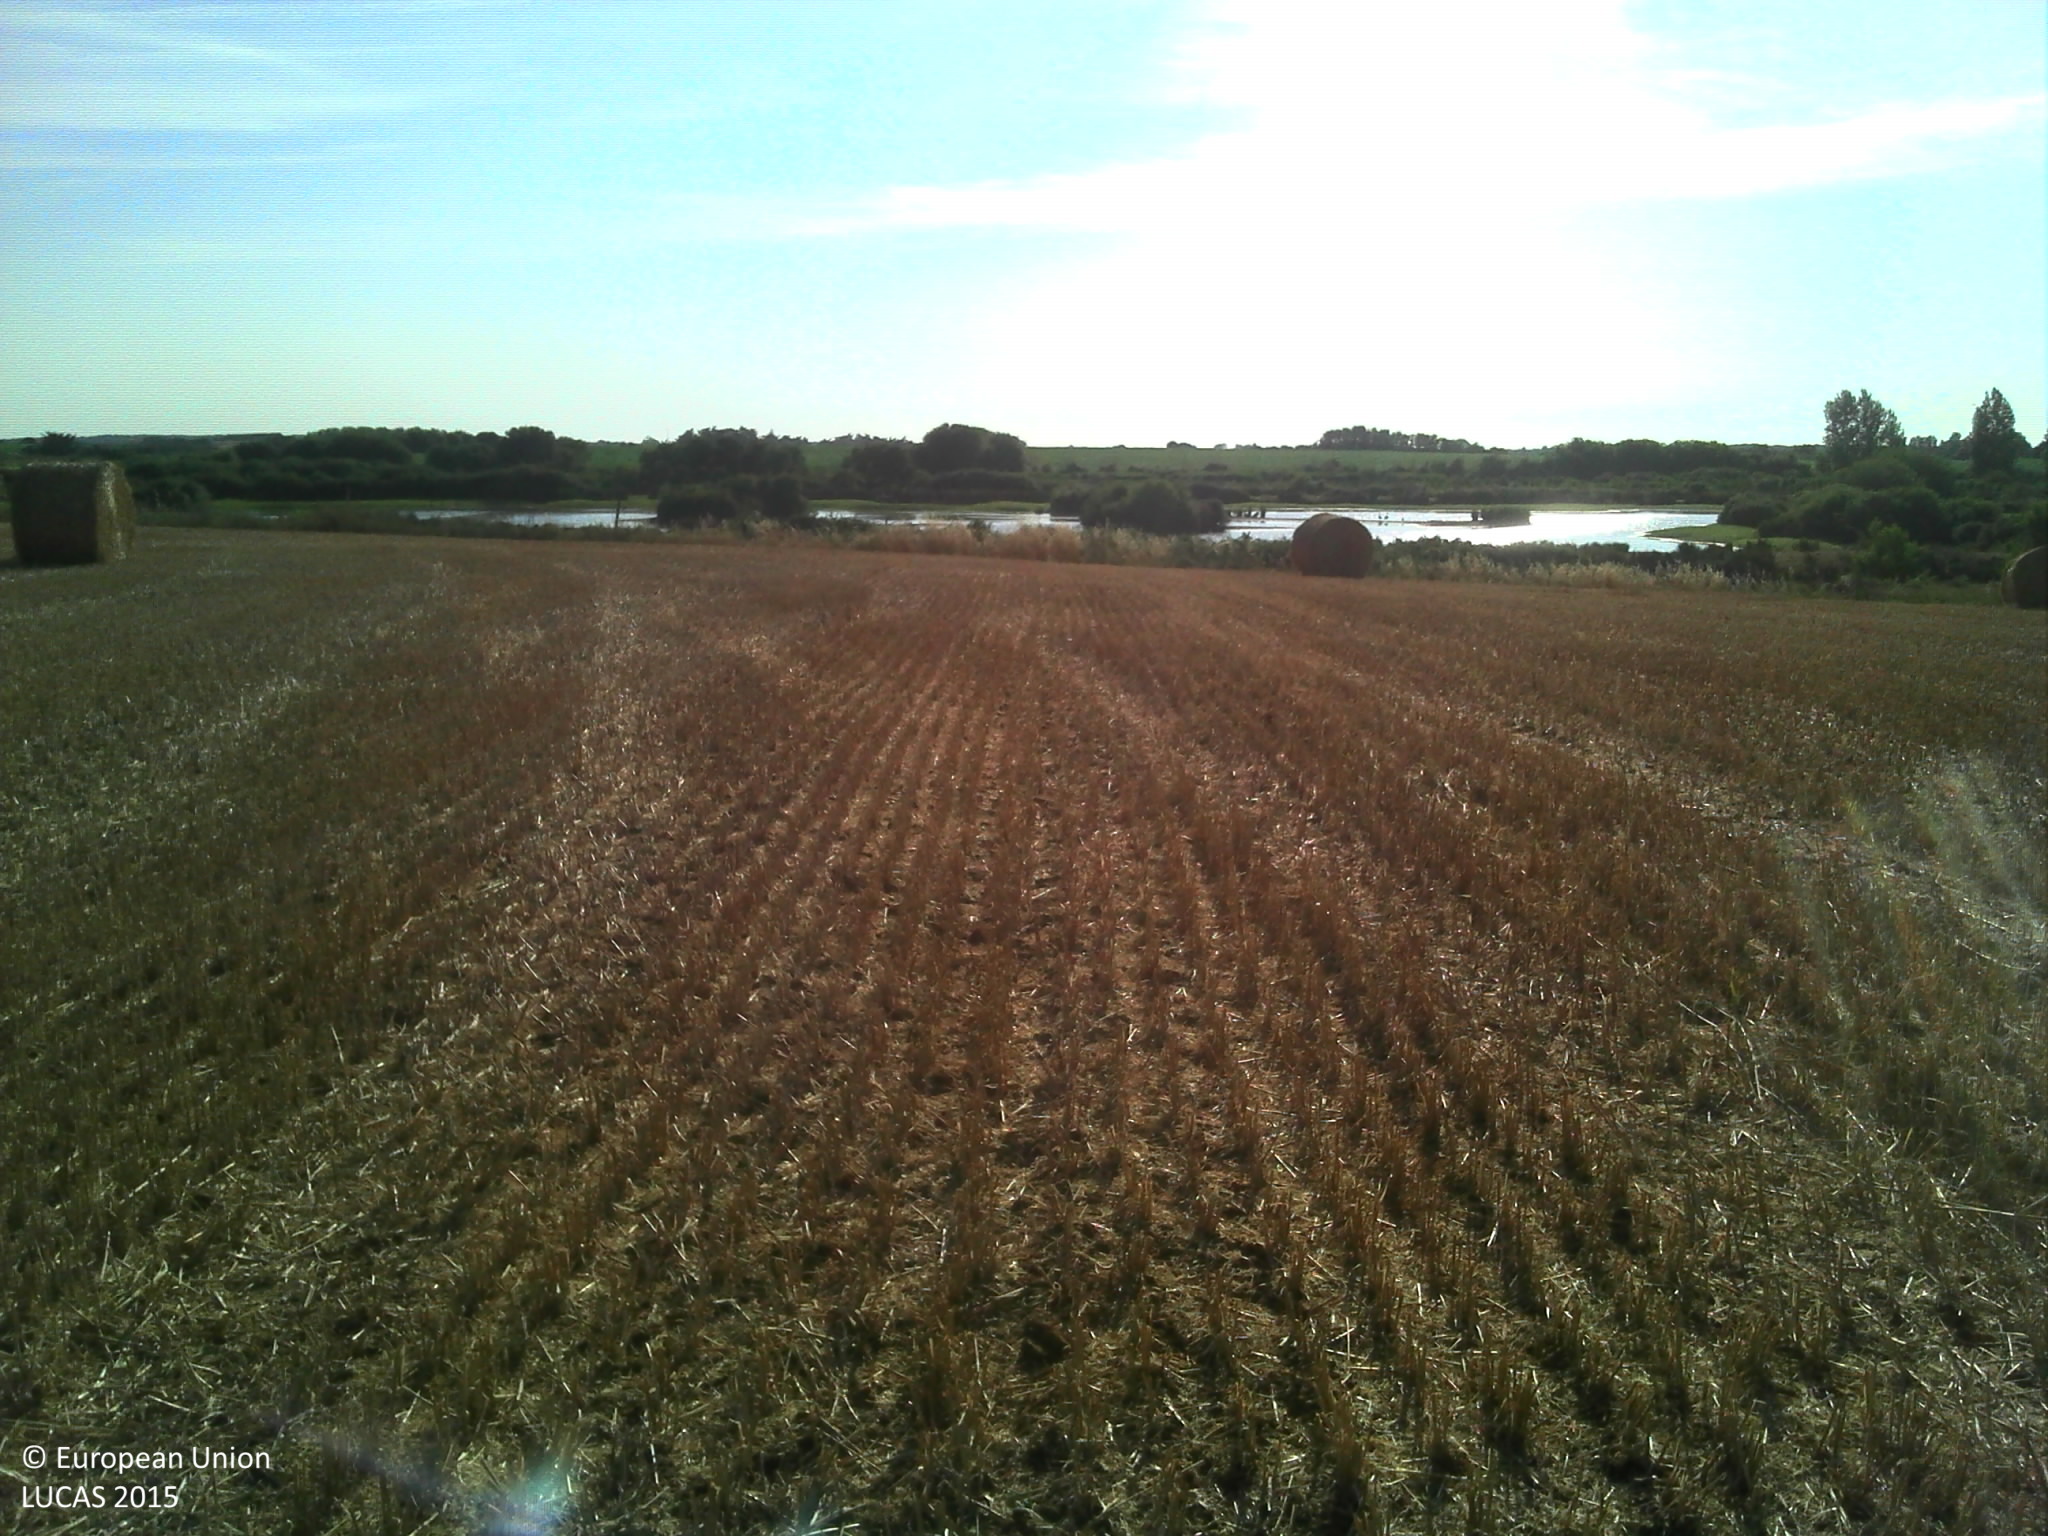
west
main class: Cropland
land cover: Common wheat
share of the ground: > 75 %
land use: Agriculture (excluding fallow land and kitchen gardens)
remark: Harvested field
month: July
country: FR
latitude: 46.4469
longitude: -1.5852
